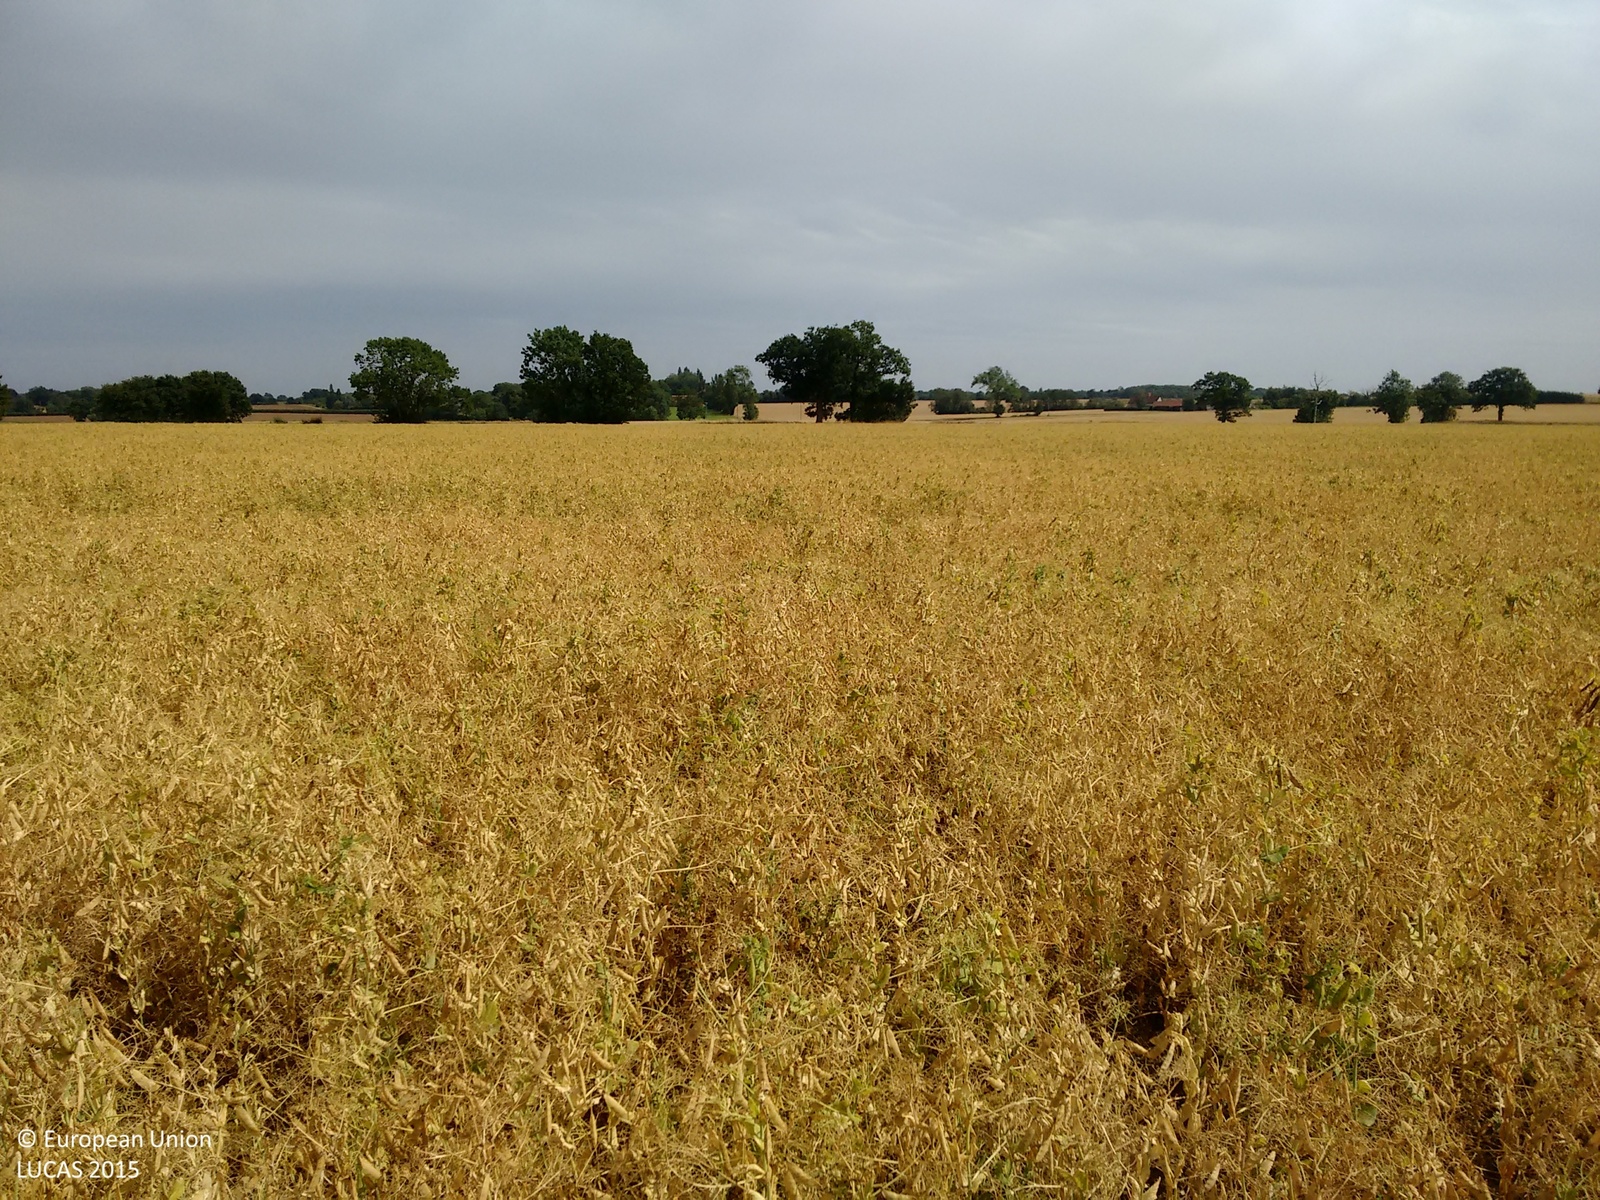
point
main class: Cropland
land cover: Dry pulses
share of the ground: > 75 %
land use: Agriculture (excluding fallow land and kitchen gardens)
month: August
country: GB
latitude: 51.9795
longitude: 0.5236
